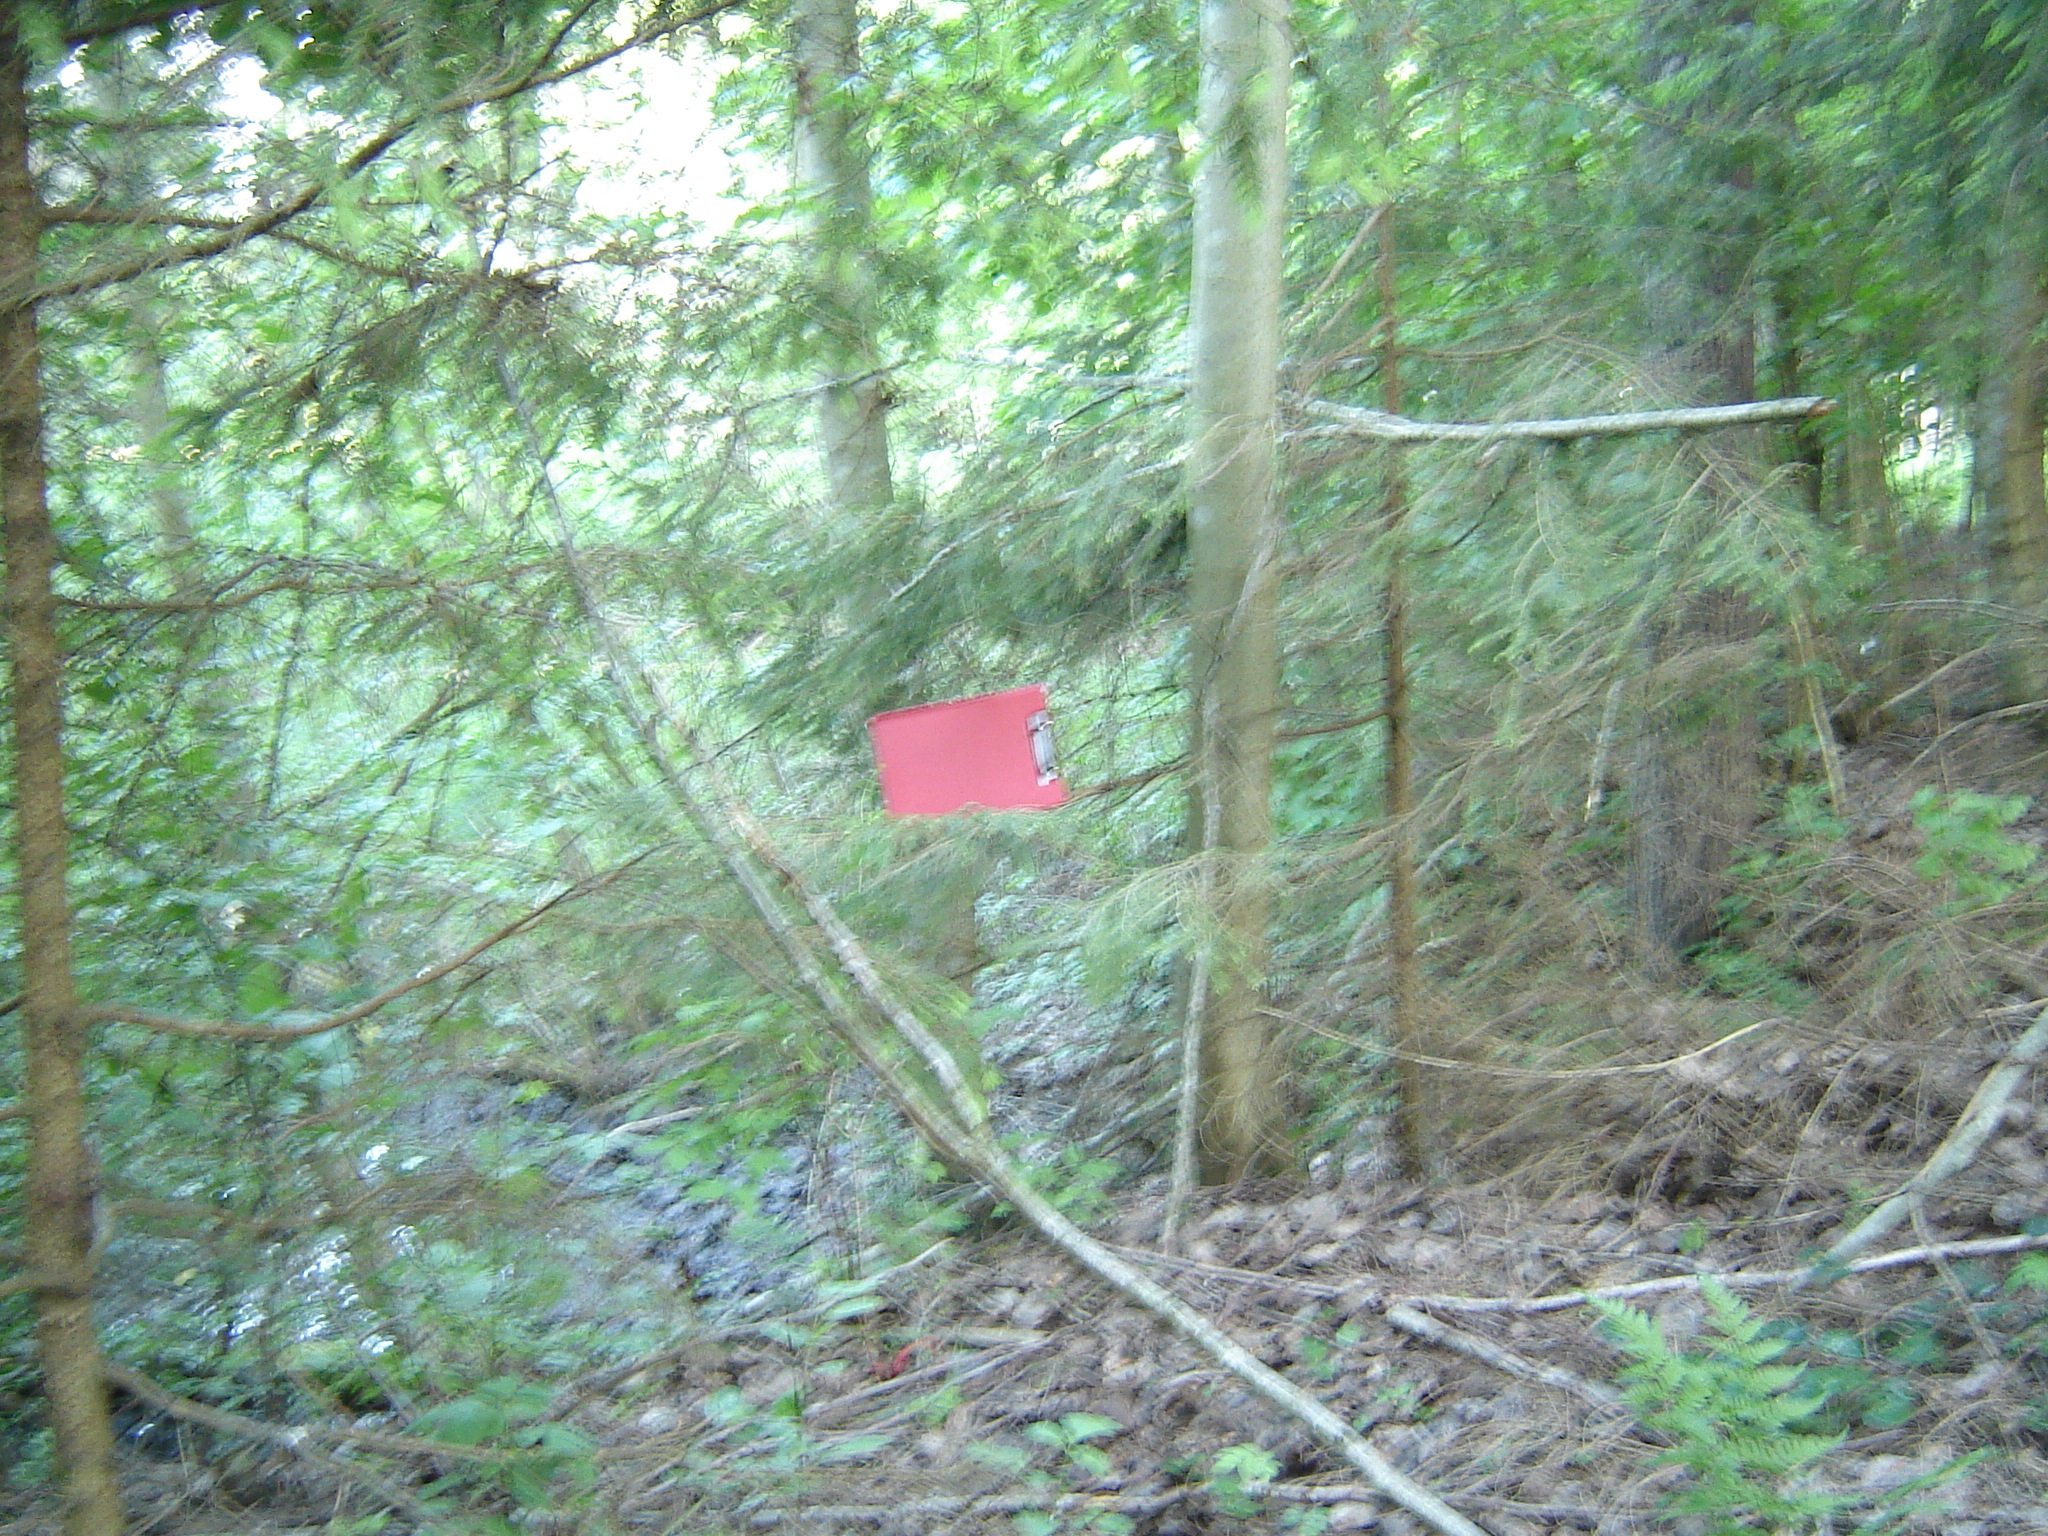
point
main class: Woodland
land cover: Spruce dominated mixed woodland
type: hemiboreal forest and nemoral coniferous forest and mixed broadleaved-coniferous forest
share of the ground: > 75 %
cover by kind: coniferous forest trees 50 %, broadleaved forest trees 50 %
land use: Forestry
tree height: > 5 m
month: June
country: LT
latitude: 55.8406
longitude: 25.3701
